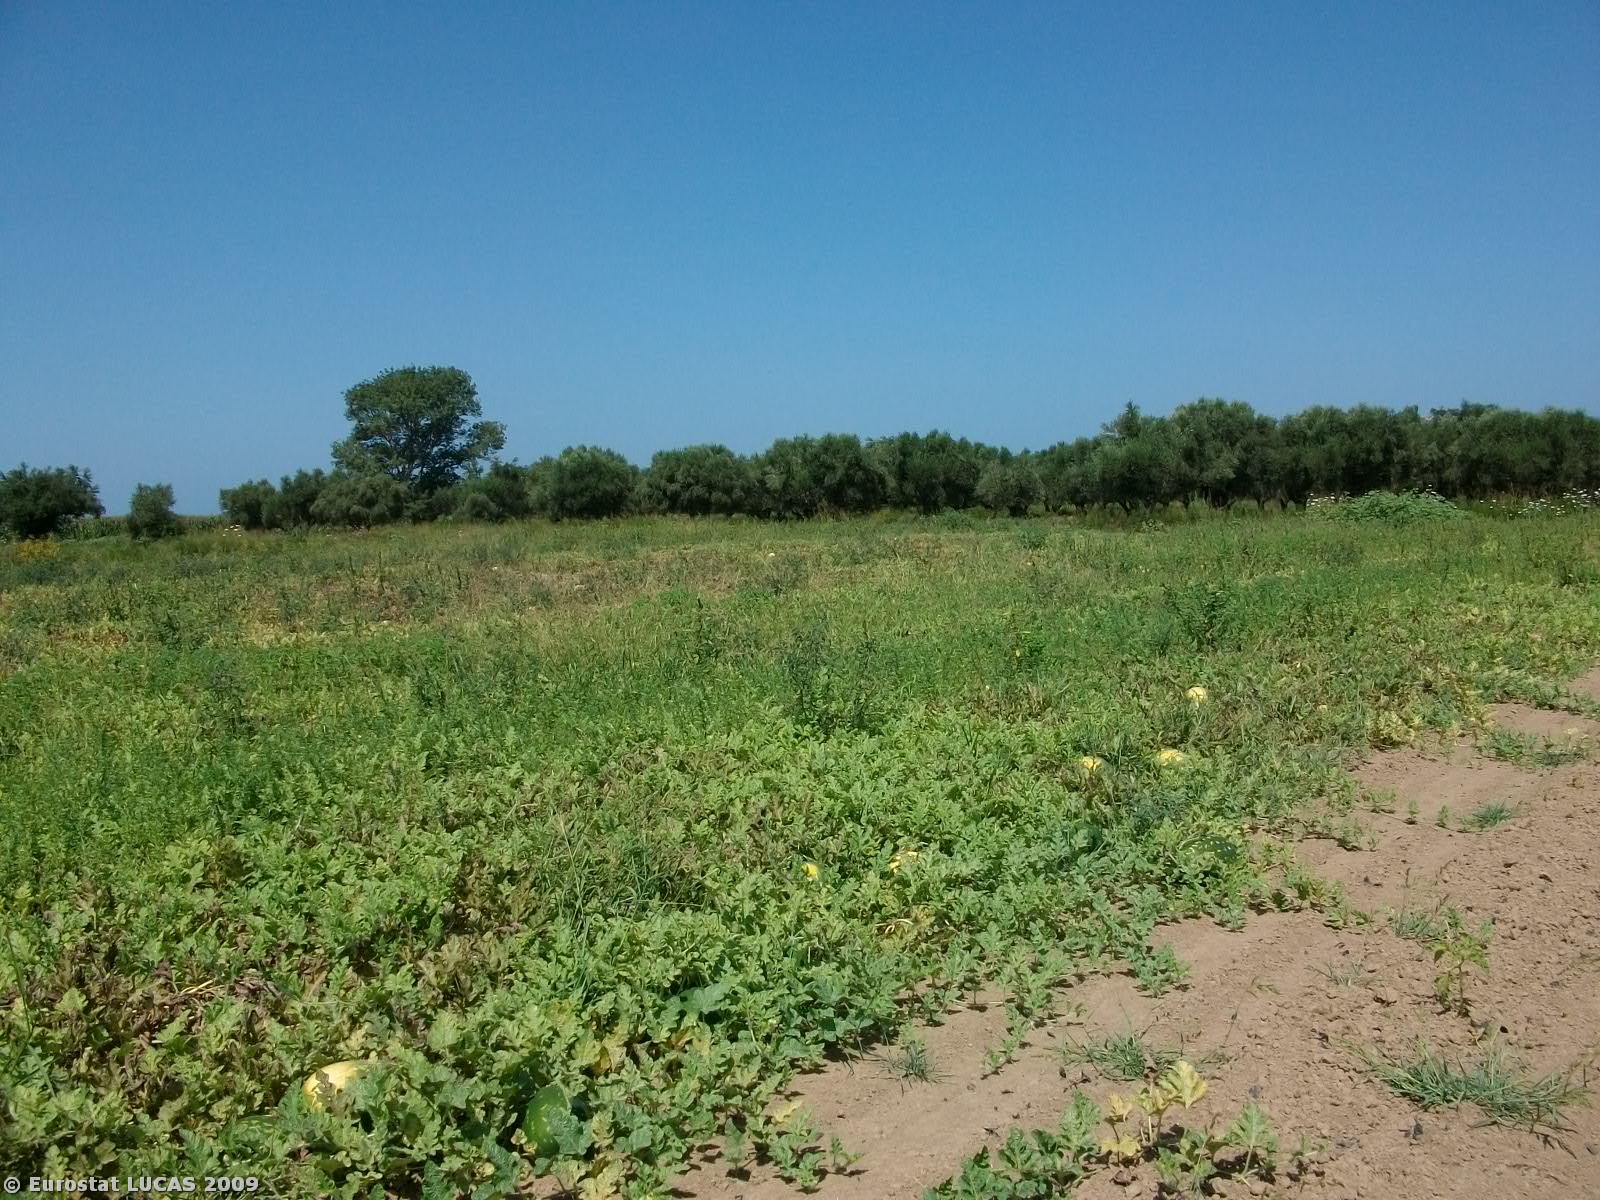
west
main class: Cropland
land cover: Other fresh vegetables
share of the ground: 50 - 75 %
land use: Agriculture (excluding fallow land and kitchen gardens)
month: July
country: GR
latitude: 38.0179
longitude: 21.3418
